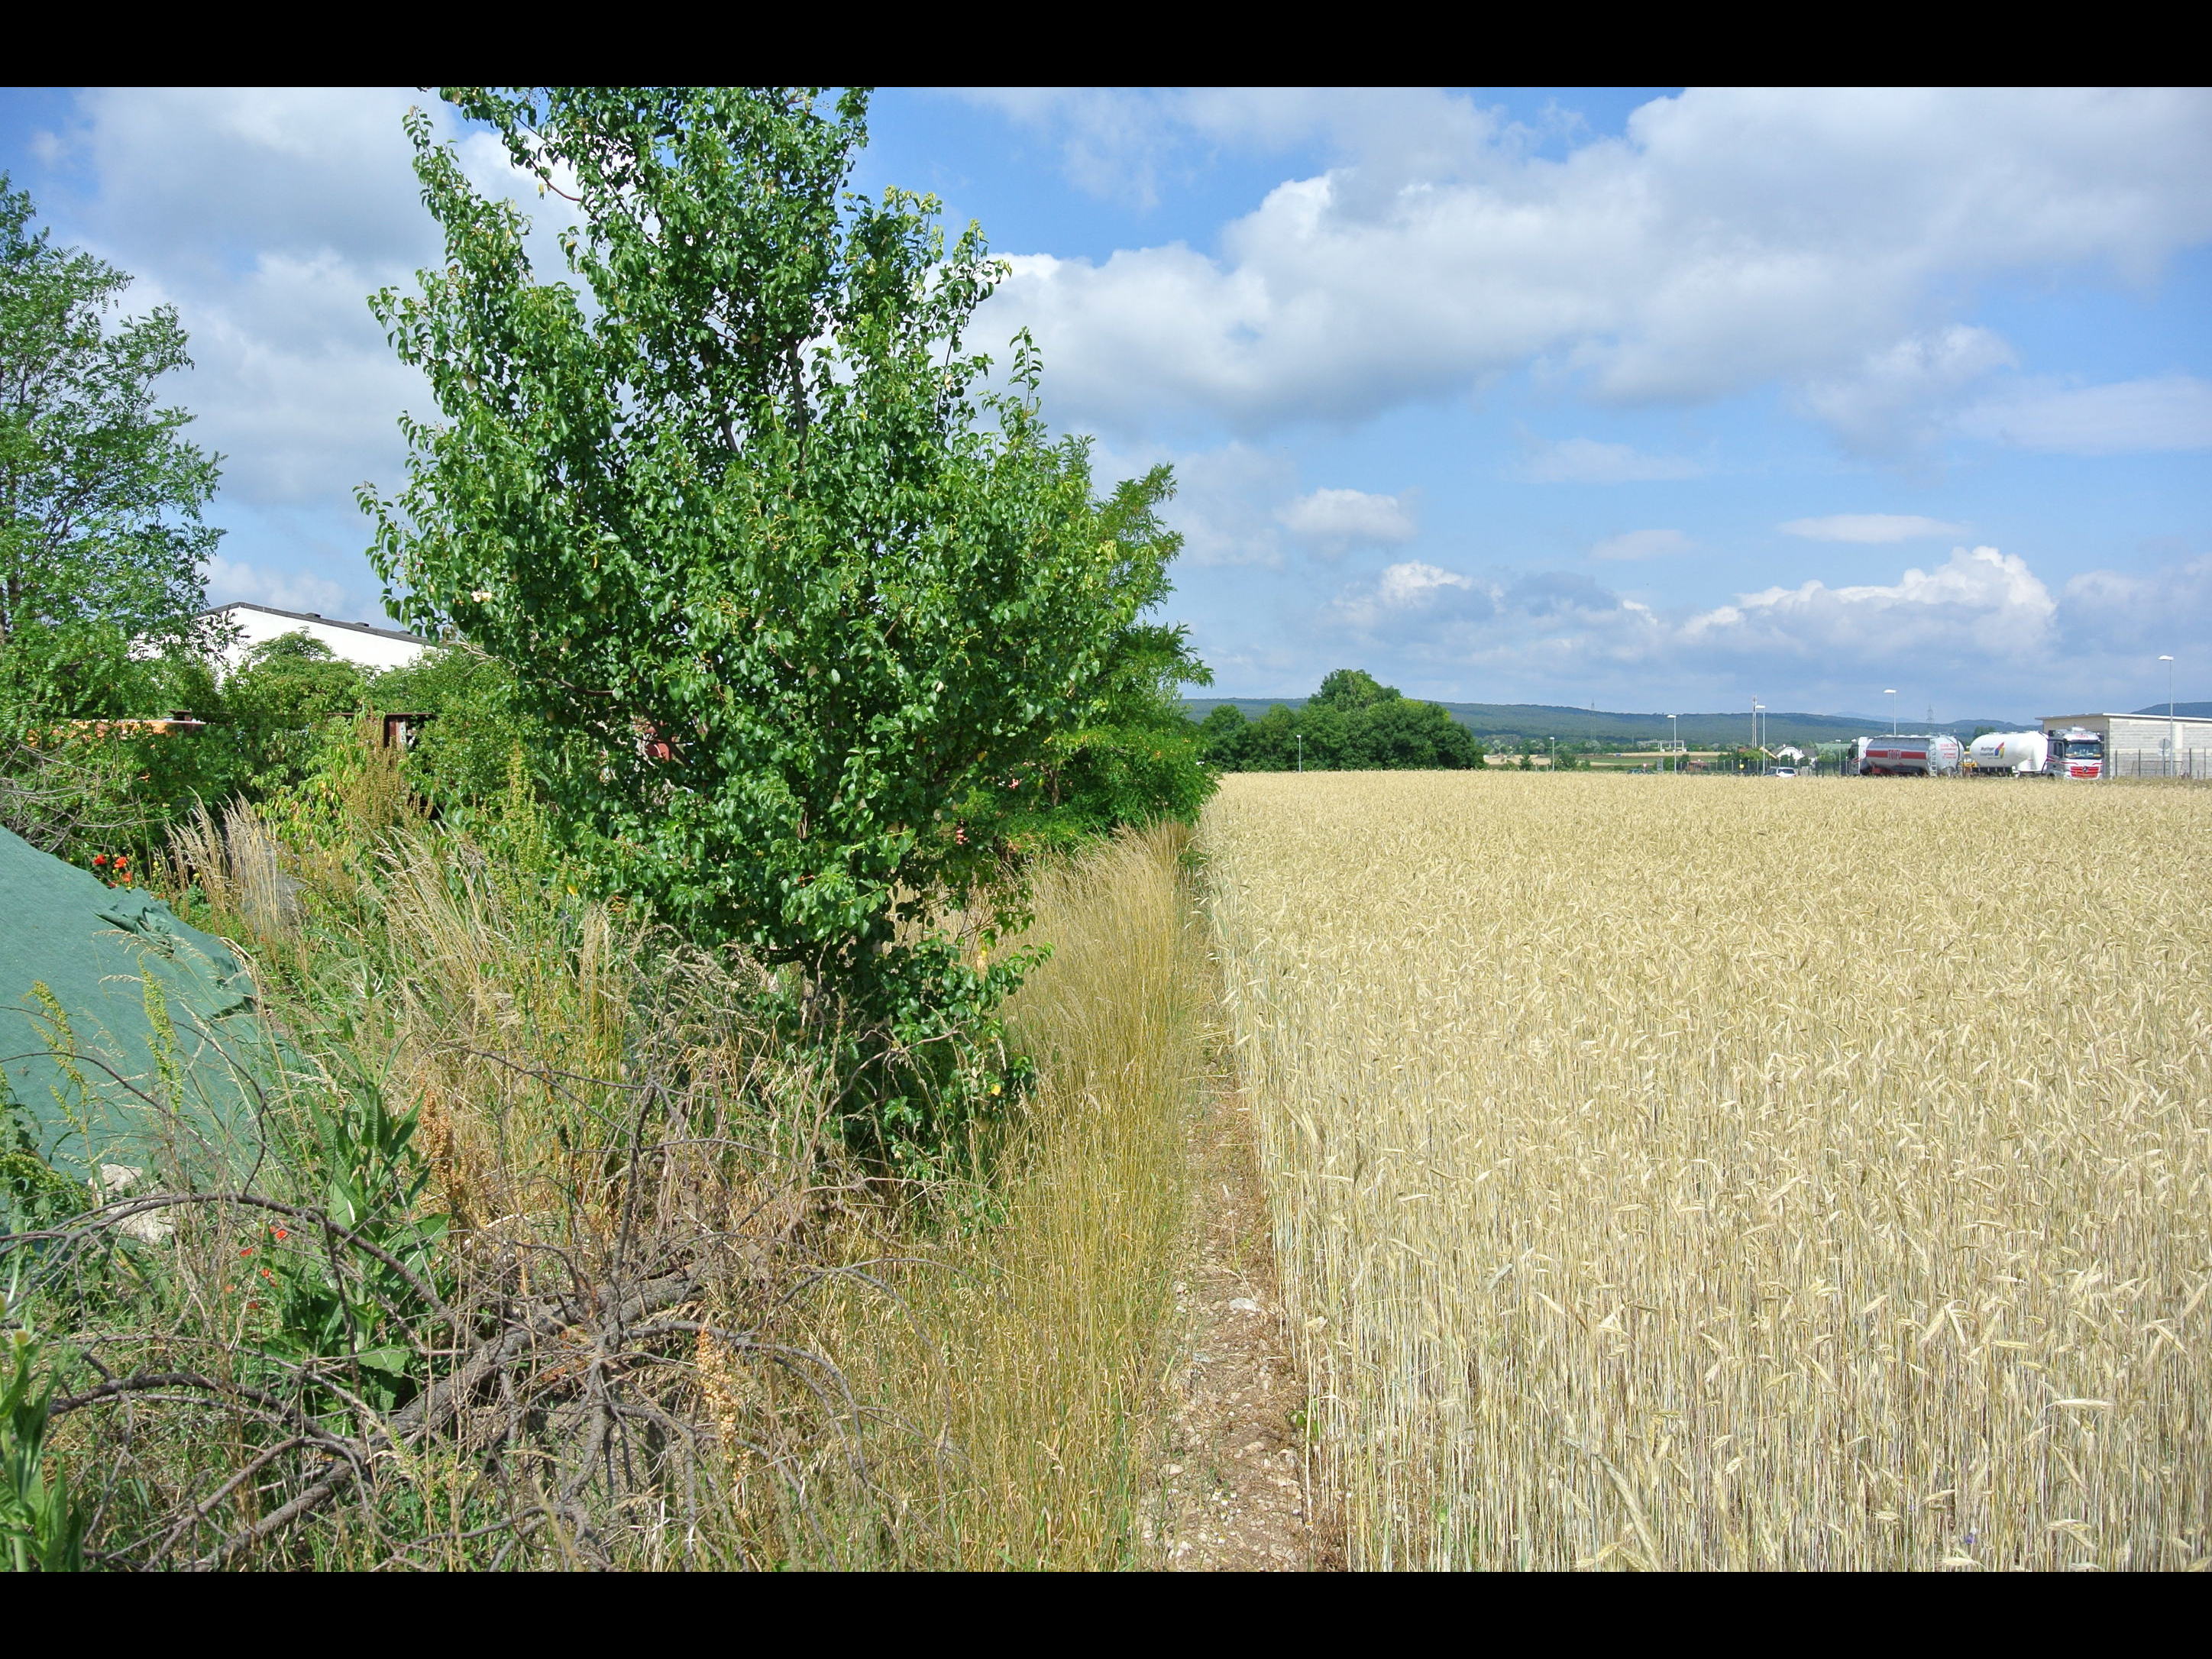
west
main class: Cropland
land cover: Barley
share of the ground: > 75 %
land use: Agriculture (excluding fallow land and kitchen gardens)
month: June
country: AT
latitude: 47.8853
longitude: 16.2223
